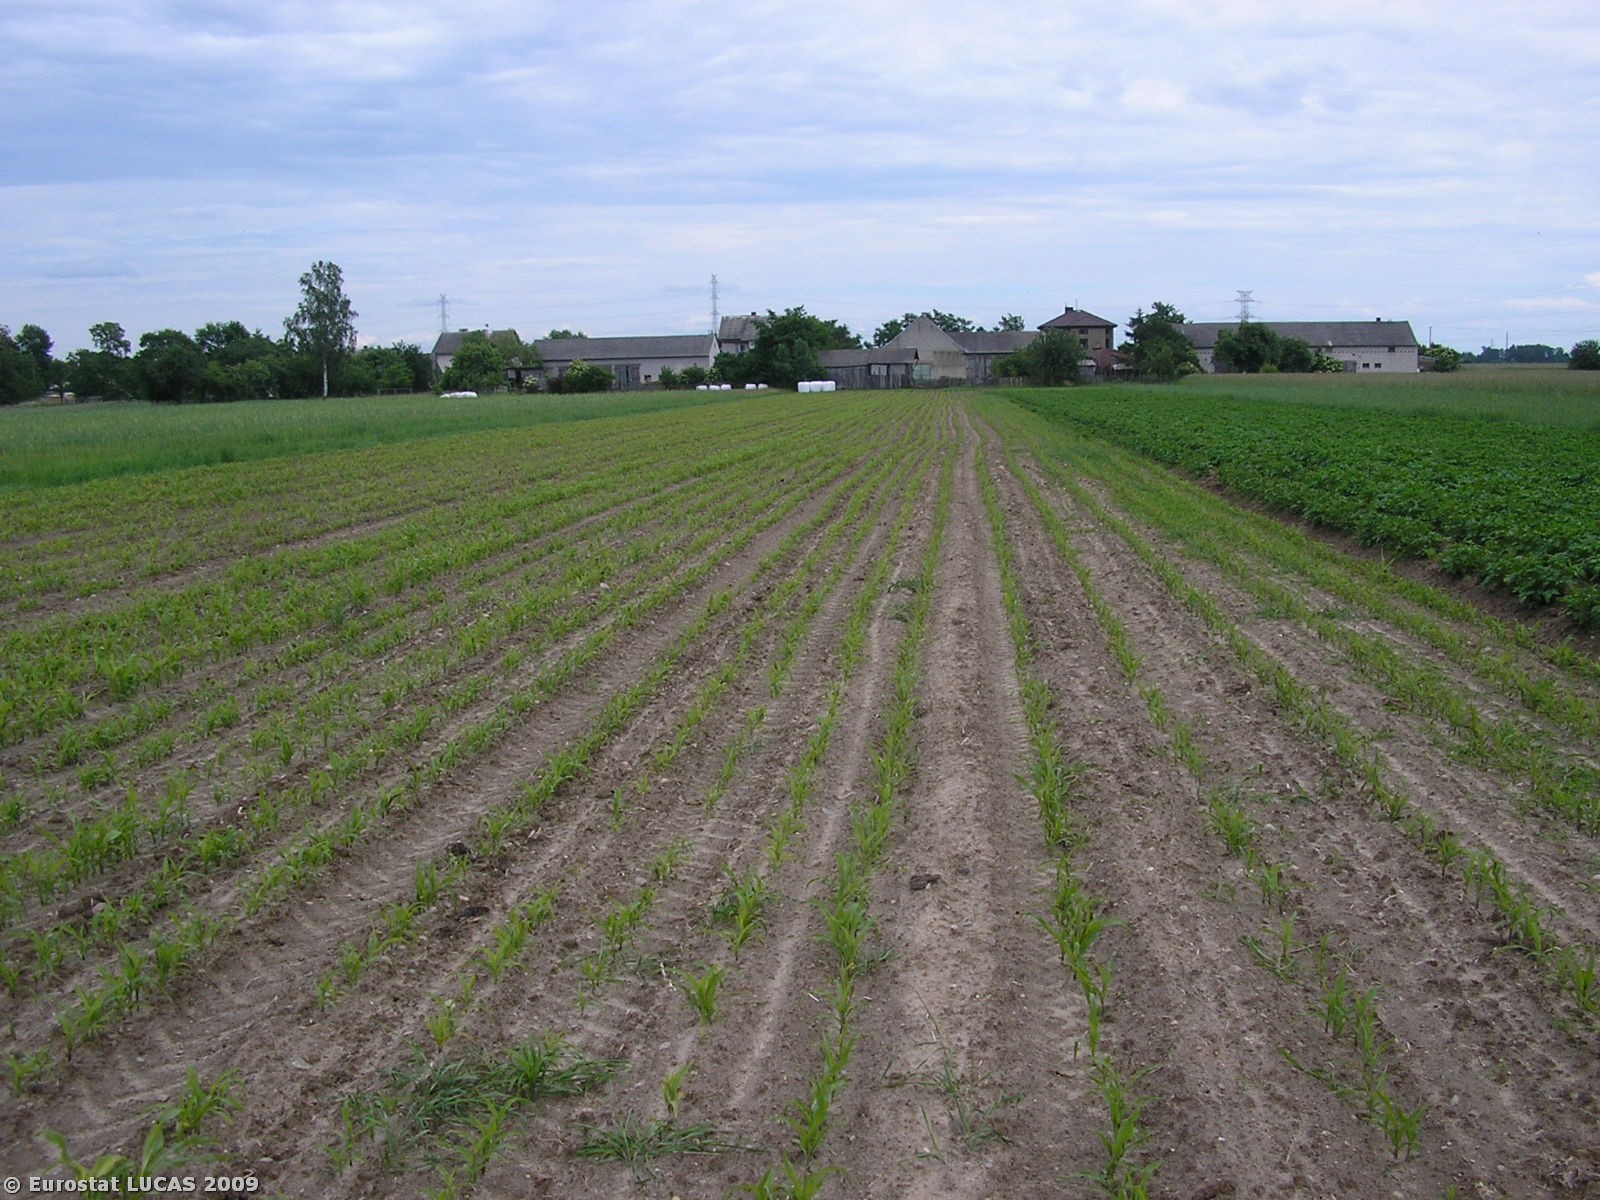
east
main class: Cropland
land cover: Maize
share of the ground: 10 - 25 %
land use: Agriculture (excluding fallow land and kitchen gardens)
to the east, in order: Maize; Grassland without tree/shrub cover; Artificial constructions in urban areas
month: June
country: PL
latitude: 51.3344
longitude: 18.9363
